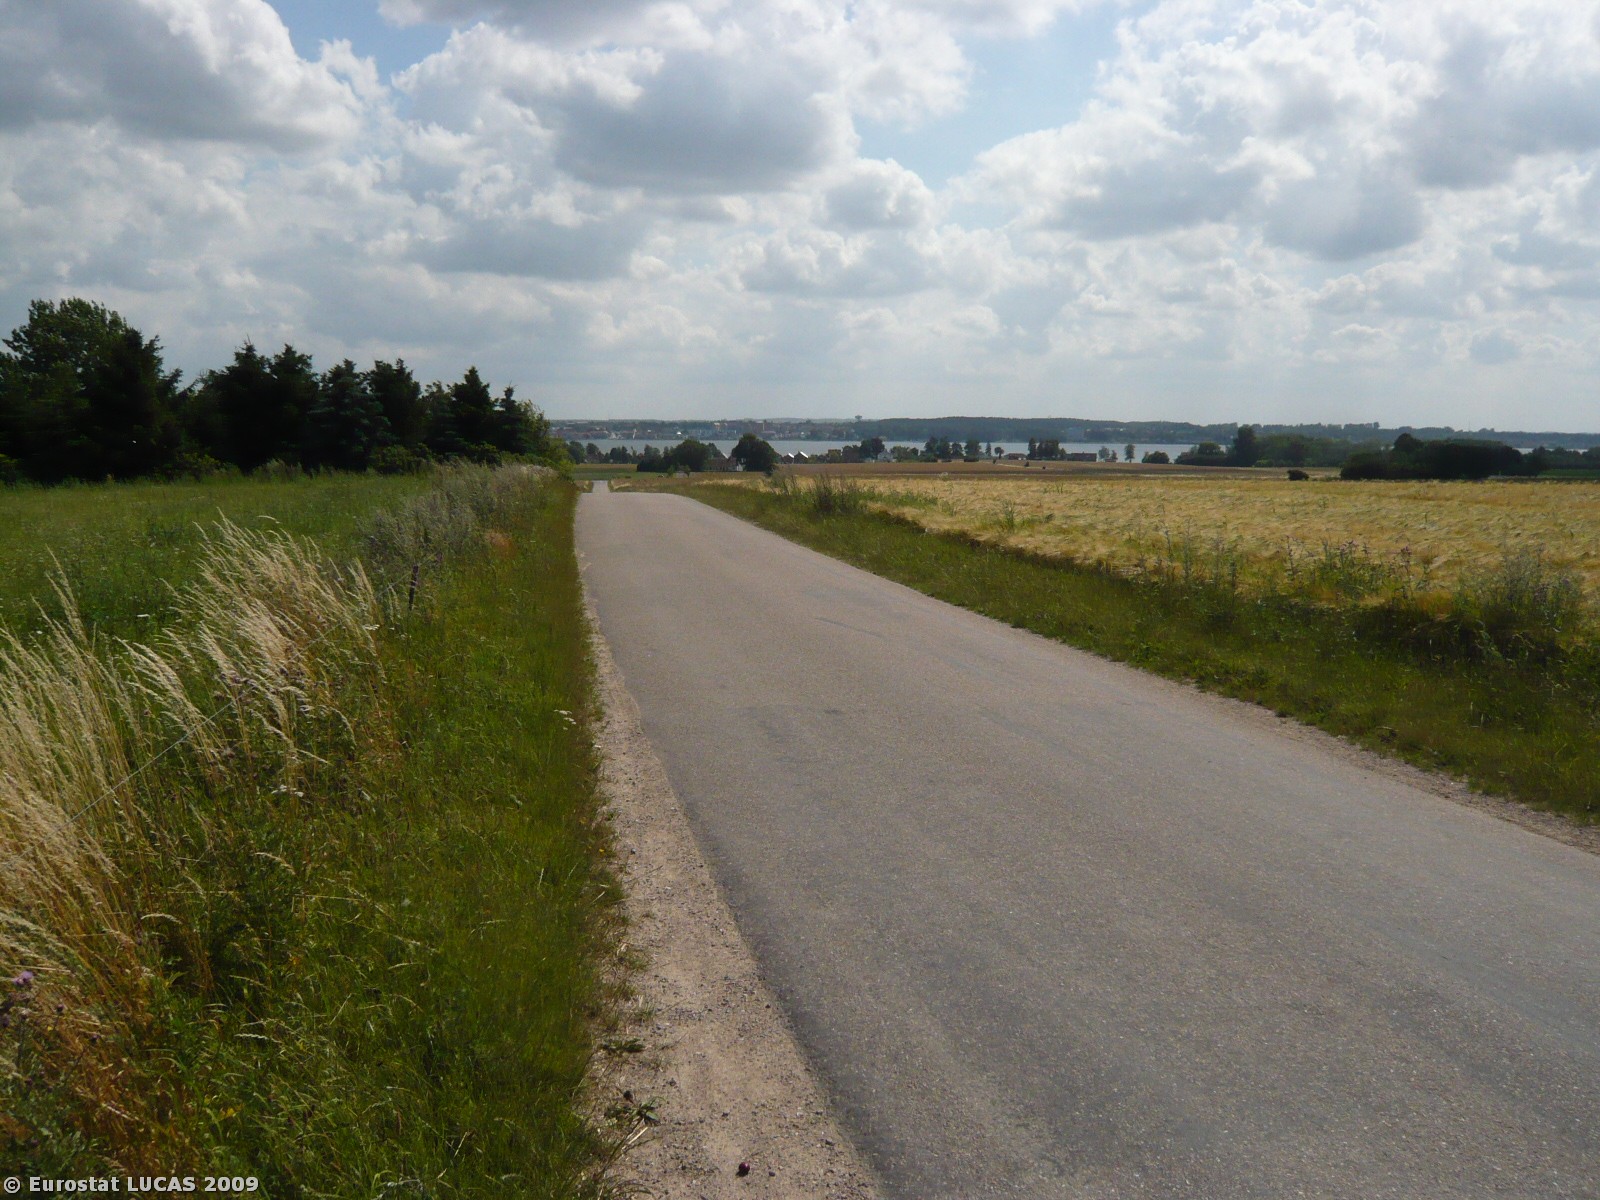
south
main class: Grassland
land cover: Grassland without tree/shrub cover
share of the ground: > 75 %
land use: Agriculture (excluding fallow land and kitchen gardens)
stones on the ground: < 10 %
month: July
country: DK
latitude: 55.7450
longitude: 11.7029
